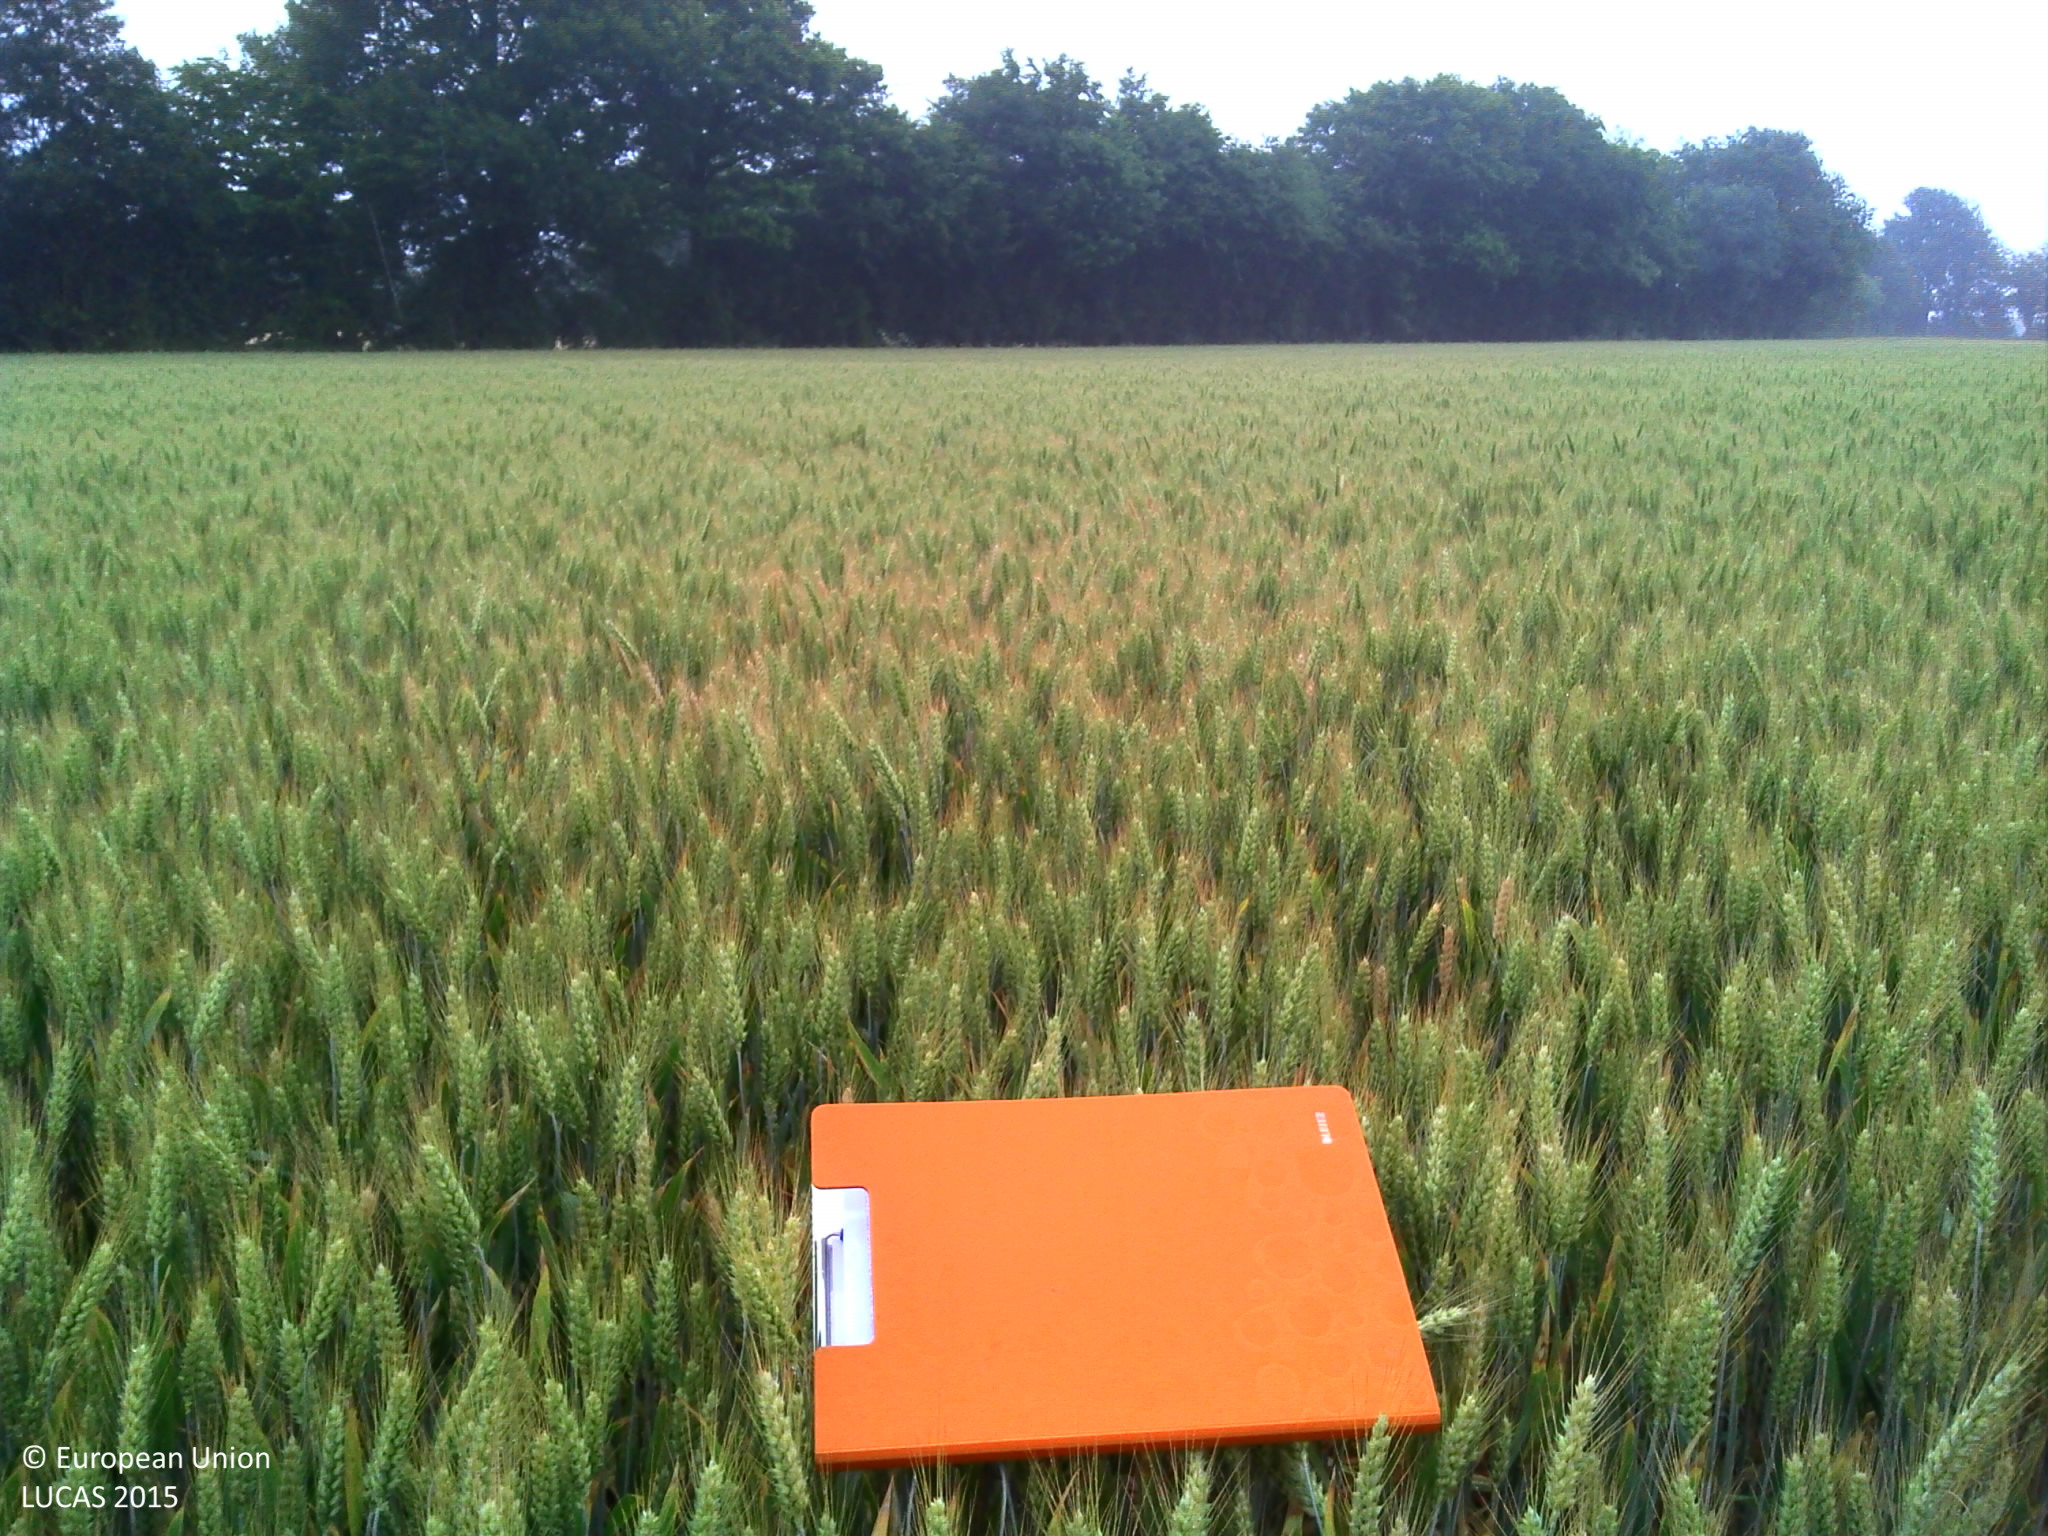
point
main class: Cropland
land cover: Common wheat
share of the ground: > 75 %
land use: Agriculture (excluding fallow land and kitchen gardens)
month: June
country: FR
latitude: 47.4832
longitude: 2.5472
